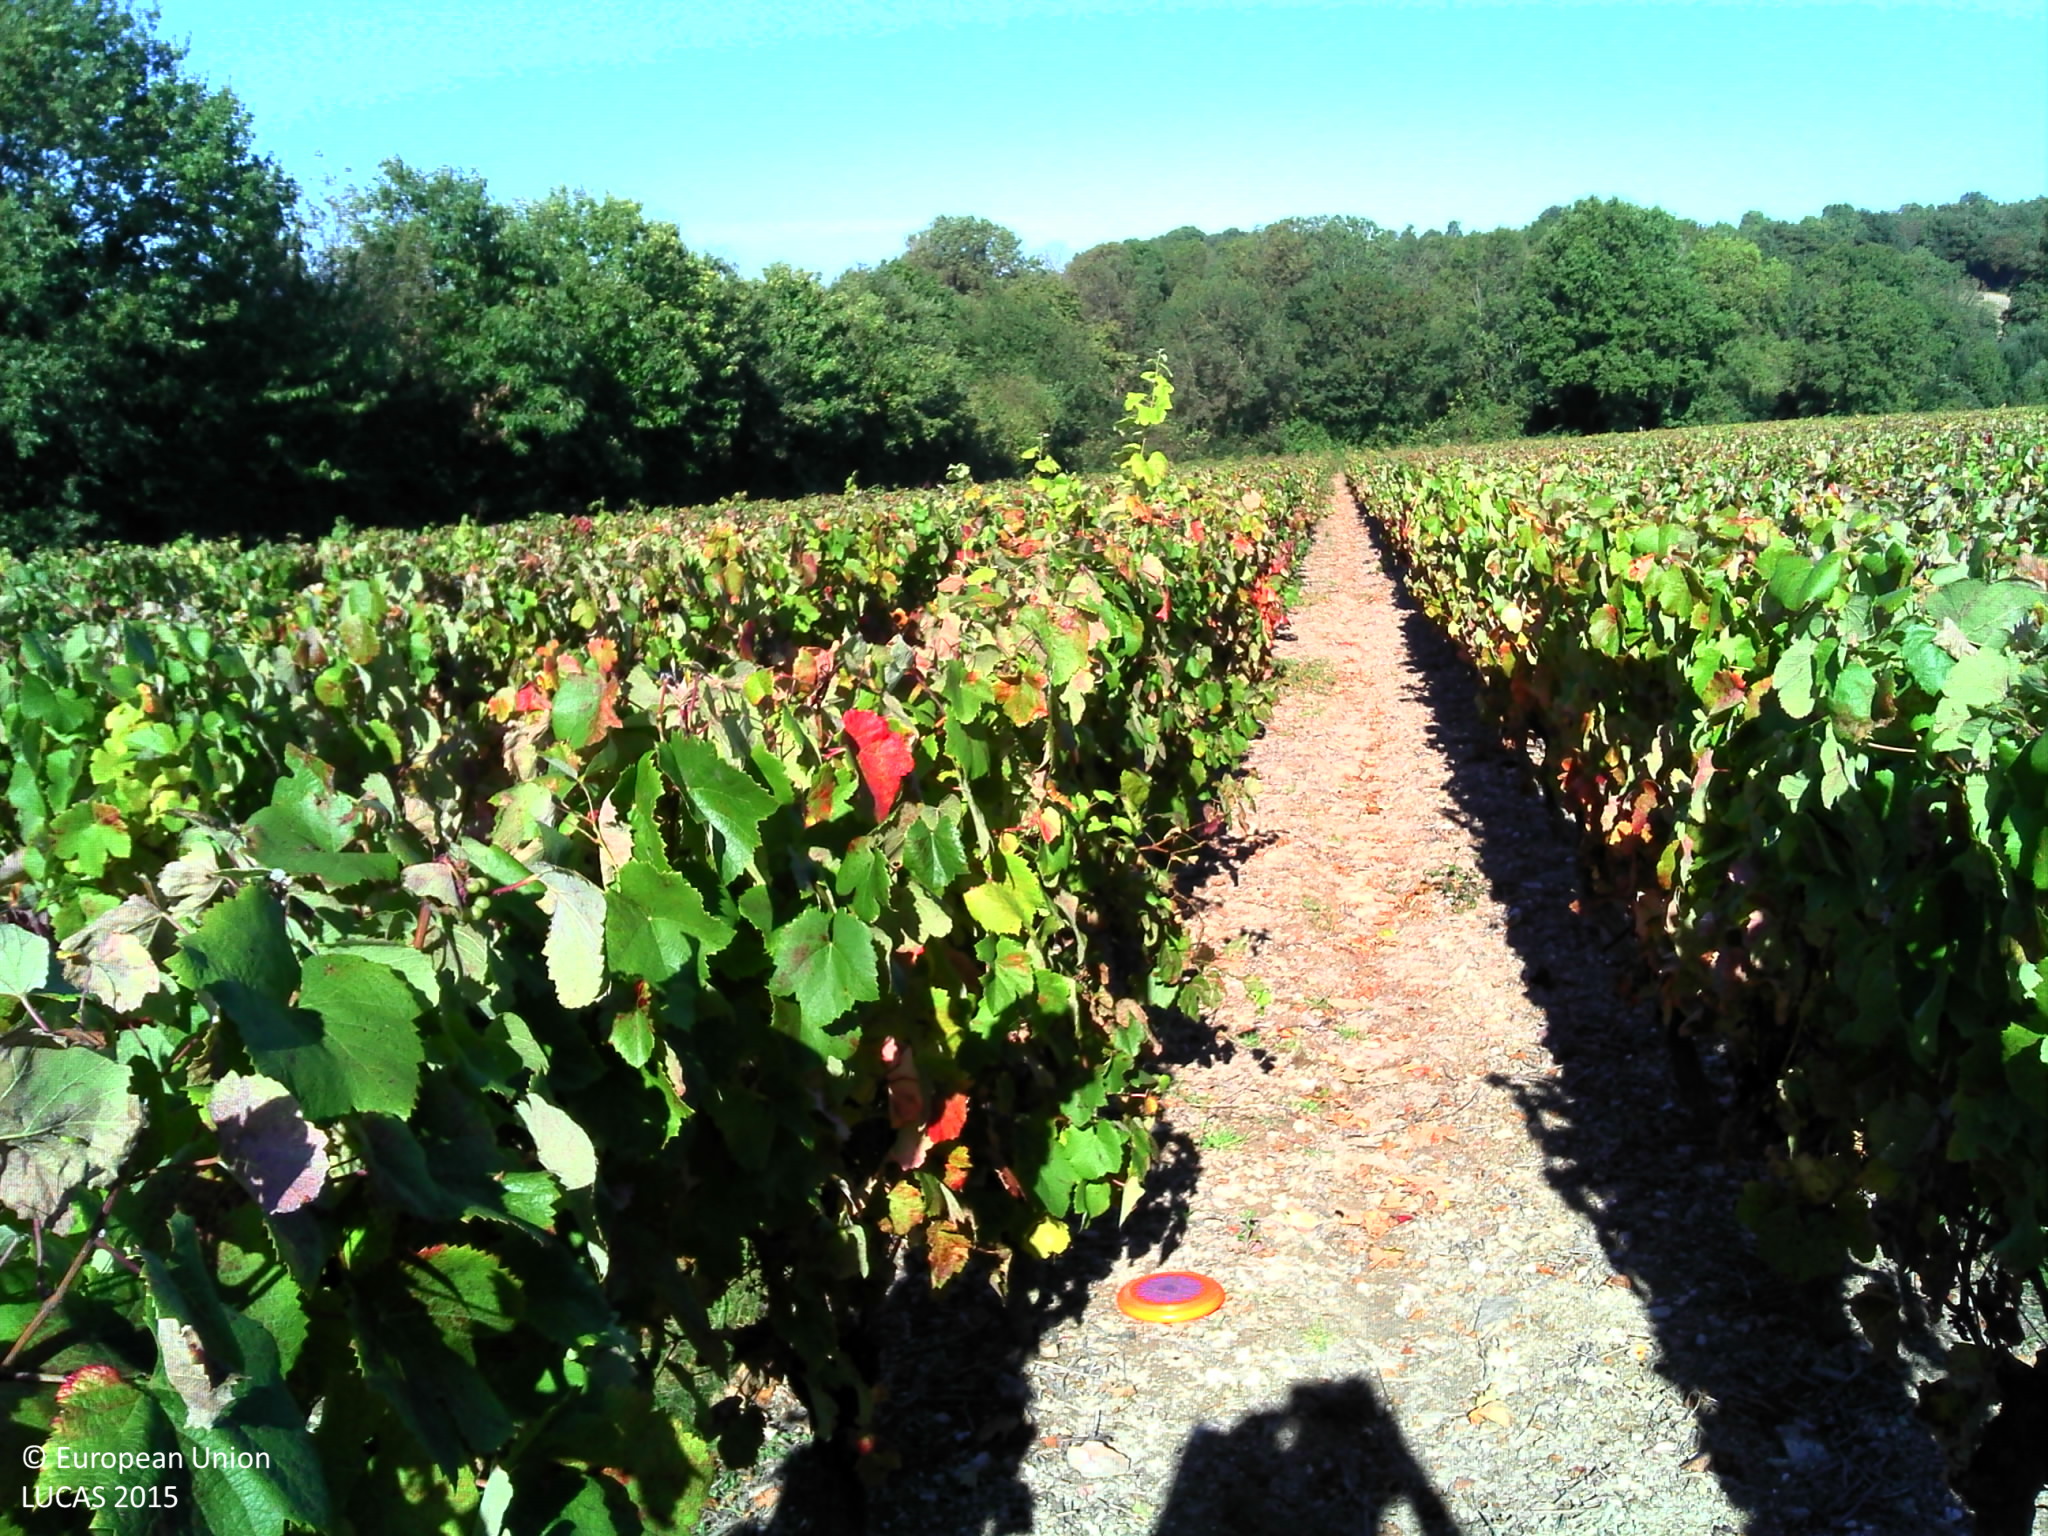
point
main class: Cropland
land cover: Vineyards
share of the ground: > 75 %
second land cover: Other bare soil
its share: > 75 %
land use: Agriculture (excluding fallow land and kitchen gardens)
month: September
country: FR
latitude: 46.5306
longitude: -1.3132
